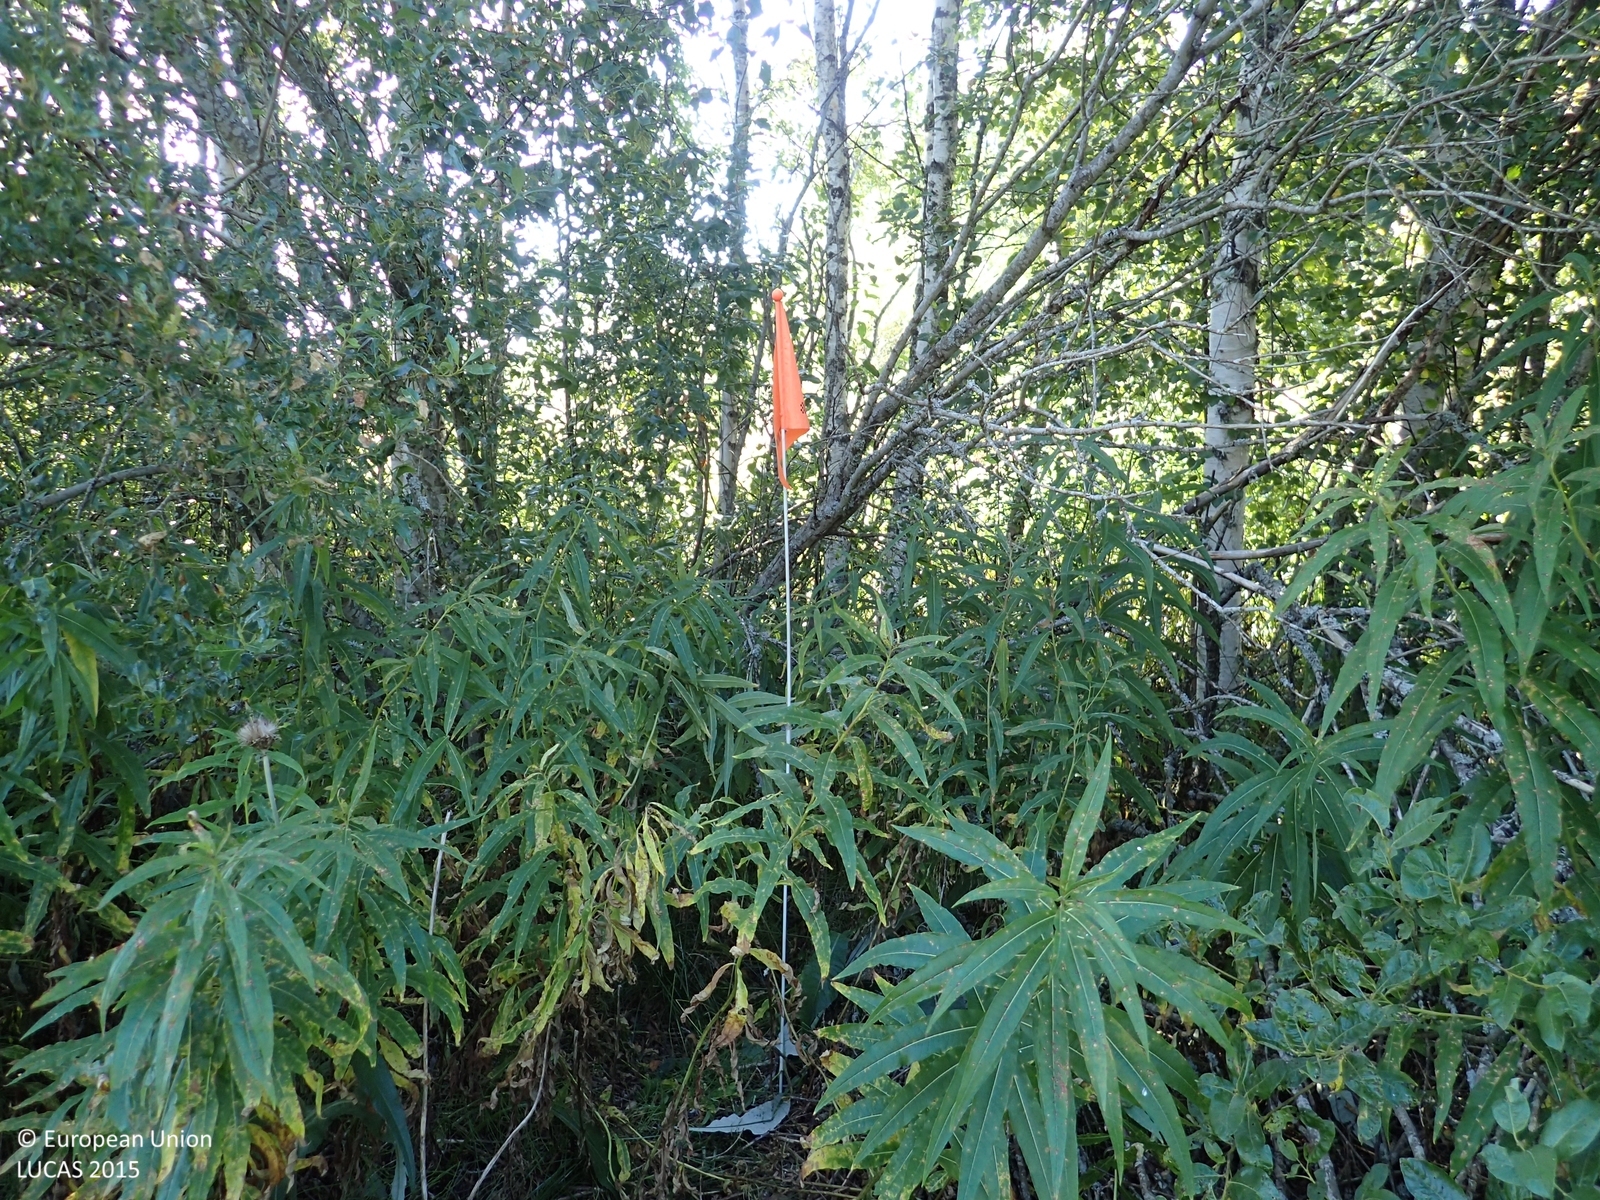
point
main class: Woodland
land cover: Broadleaved woodland
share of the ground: > 75 %
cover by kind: broadleaved forest trees 90 %, herbaceous plants 10 %
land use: Abandoned areas
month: August
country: FI
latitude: 62.5503
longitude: 22.0077
